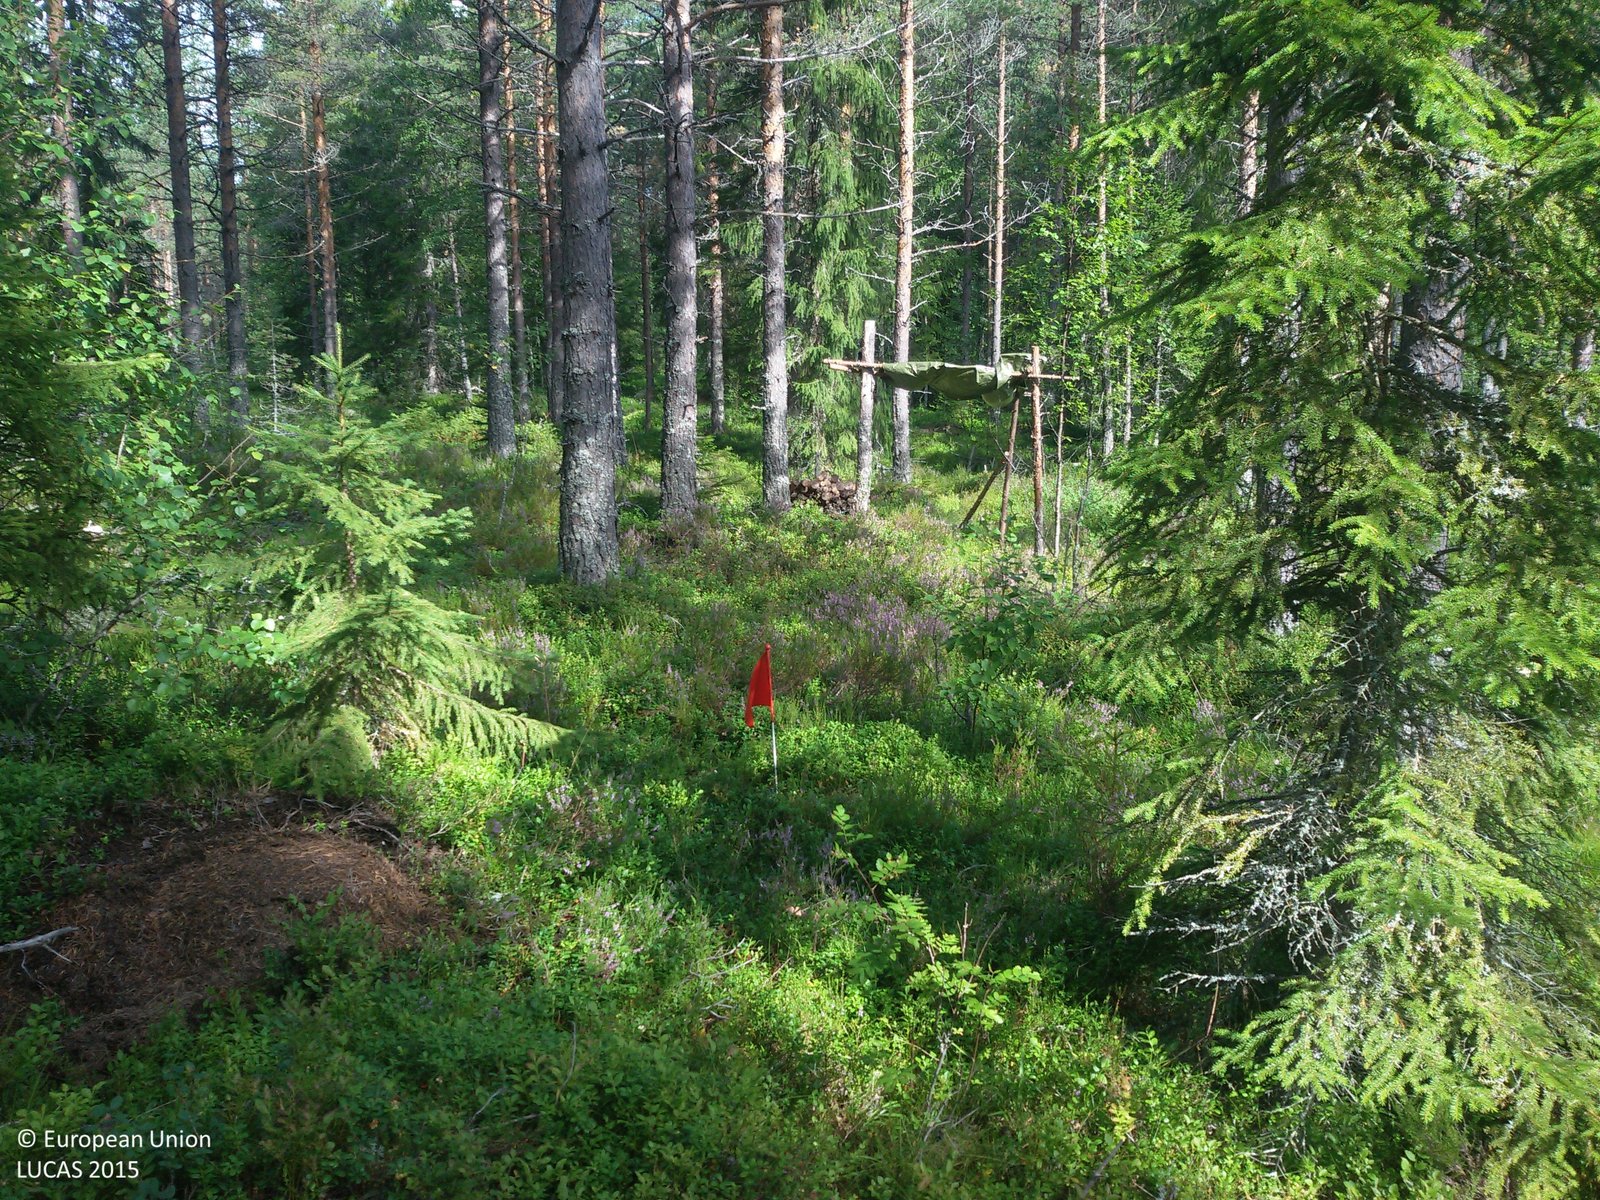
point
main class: Woodland
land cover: Pine dominated coniferous woodland
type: boreal forest
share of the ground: 50 - 75 %
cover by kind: coniferous forest trees 70 %, herbaceous plants 25 %, lichens and mosses 5 %
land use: Forestry
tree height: > 5 m
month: August
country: SE
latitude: 60.9762
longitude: 15.9541
